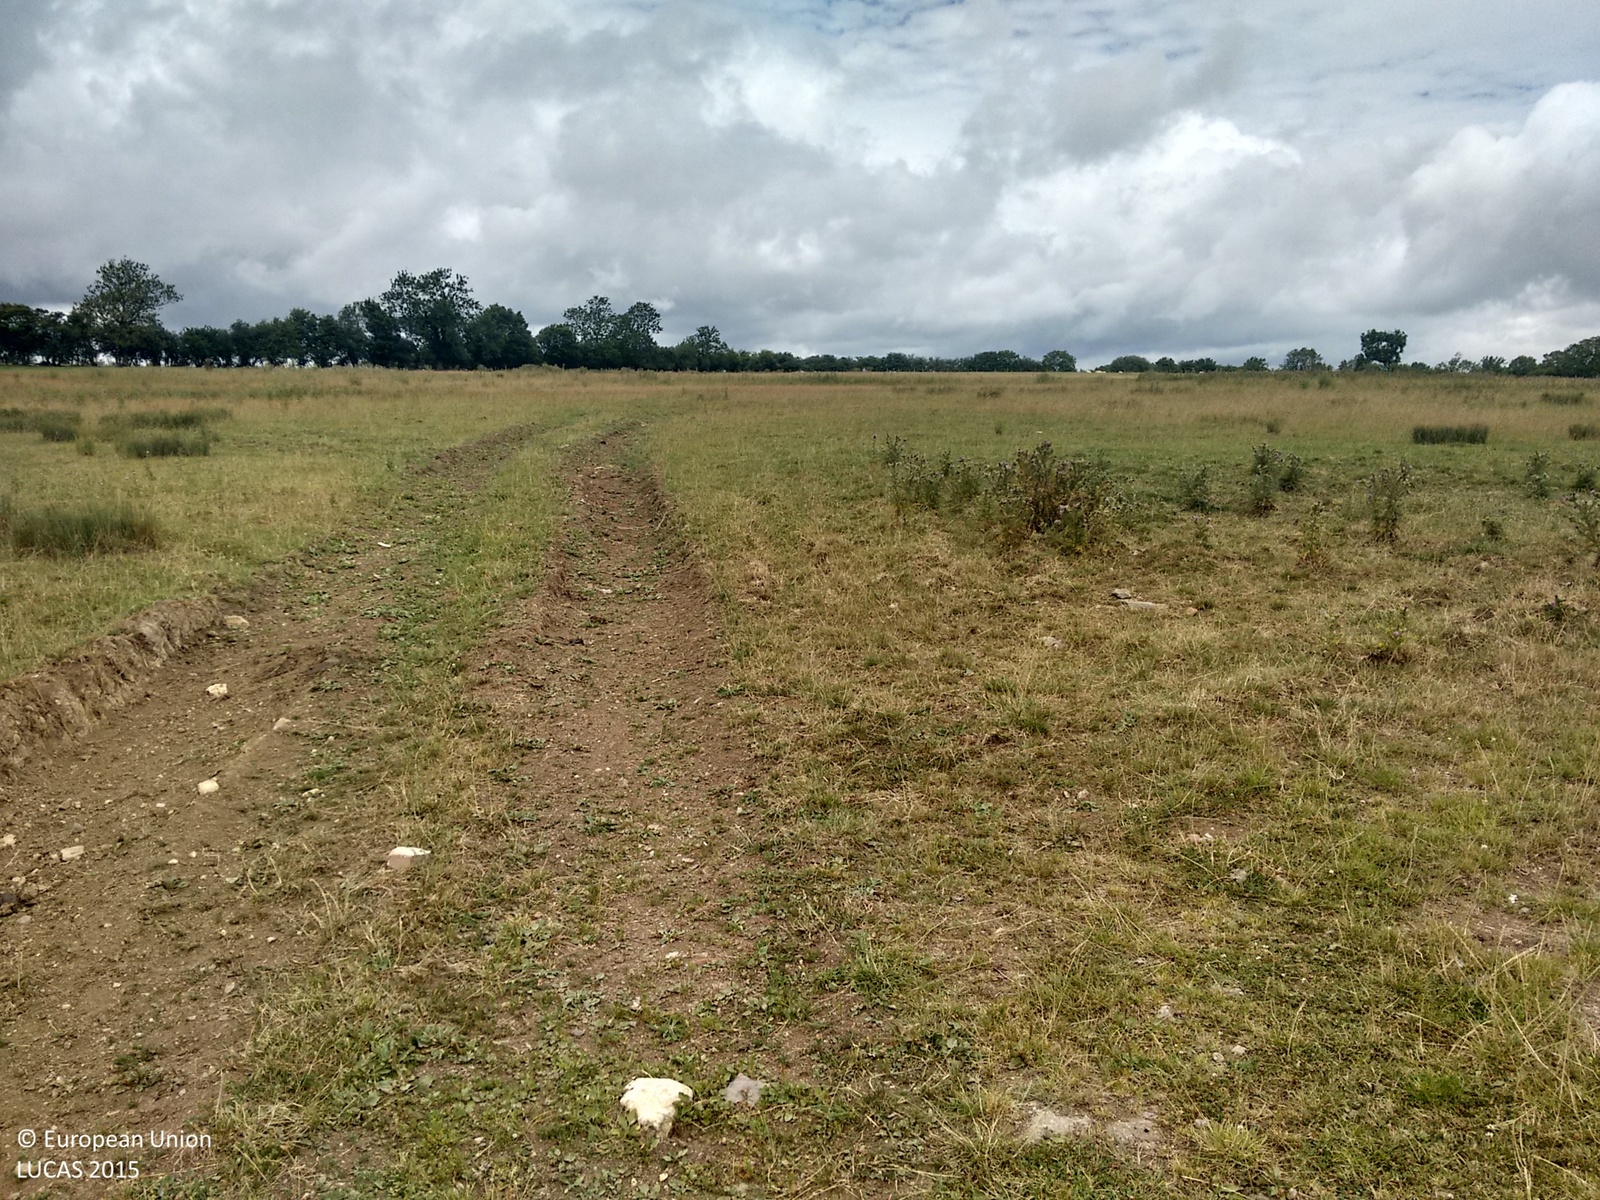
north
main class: Grassland
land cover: Grassland without tree/shrub cover
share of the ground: > 75 %
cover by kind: herbaceous plants 100 %
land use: Agriculture (excluding fallow land and kitchen gardens)
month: July
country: GB
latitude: 51.5076
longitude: -2.3833
